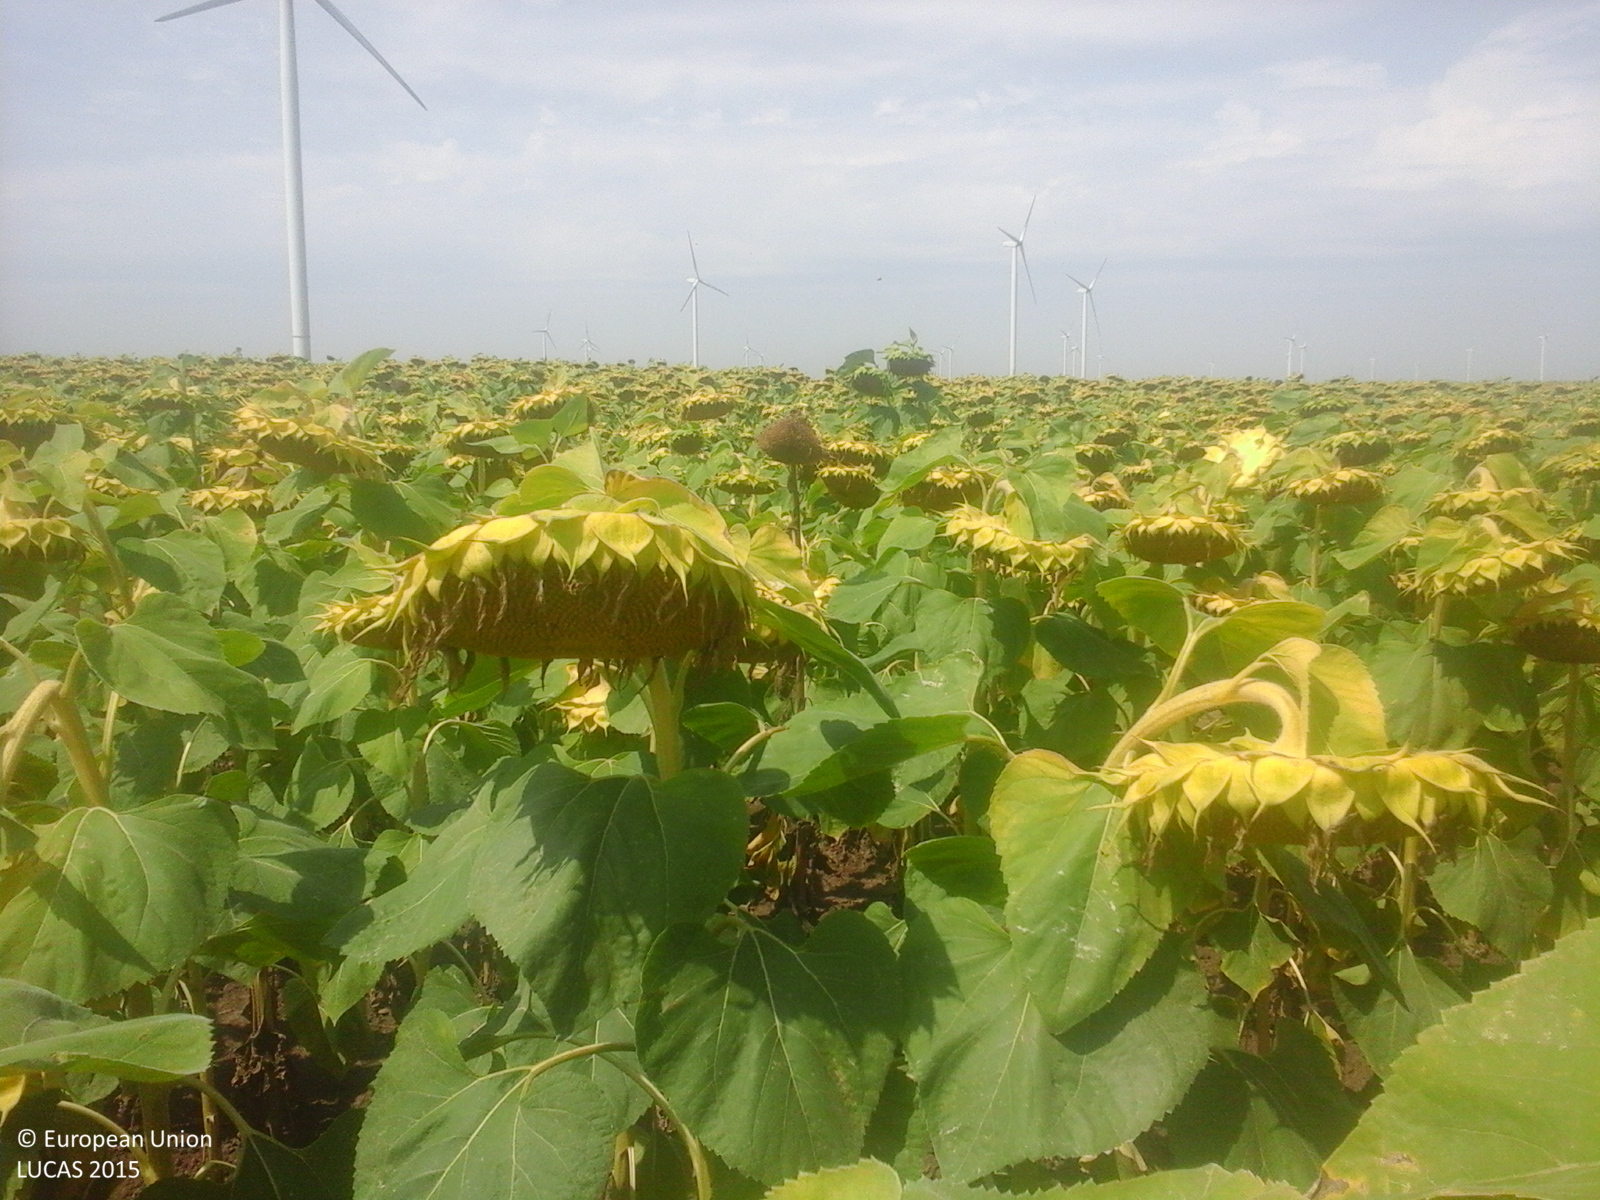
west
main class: Cropland
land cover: Sunflower
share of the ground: > 75 %
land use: Agriculture (excluding fallow land and kitchen gardens)
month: August
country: RO
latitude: 43.8882
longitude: 28.1929
